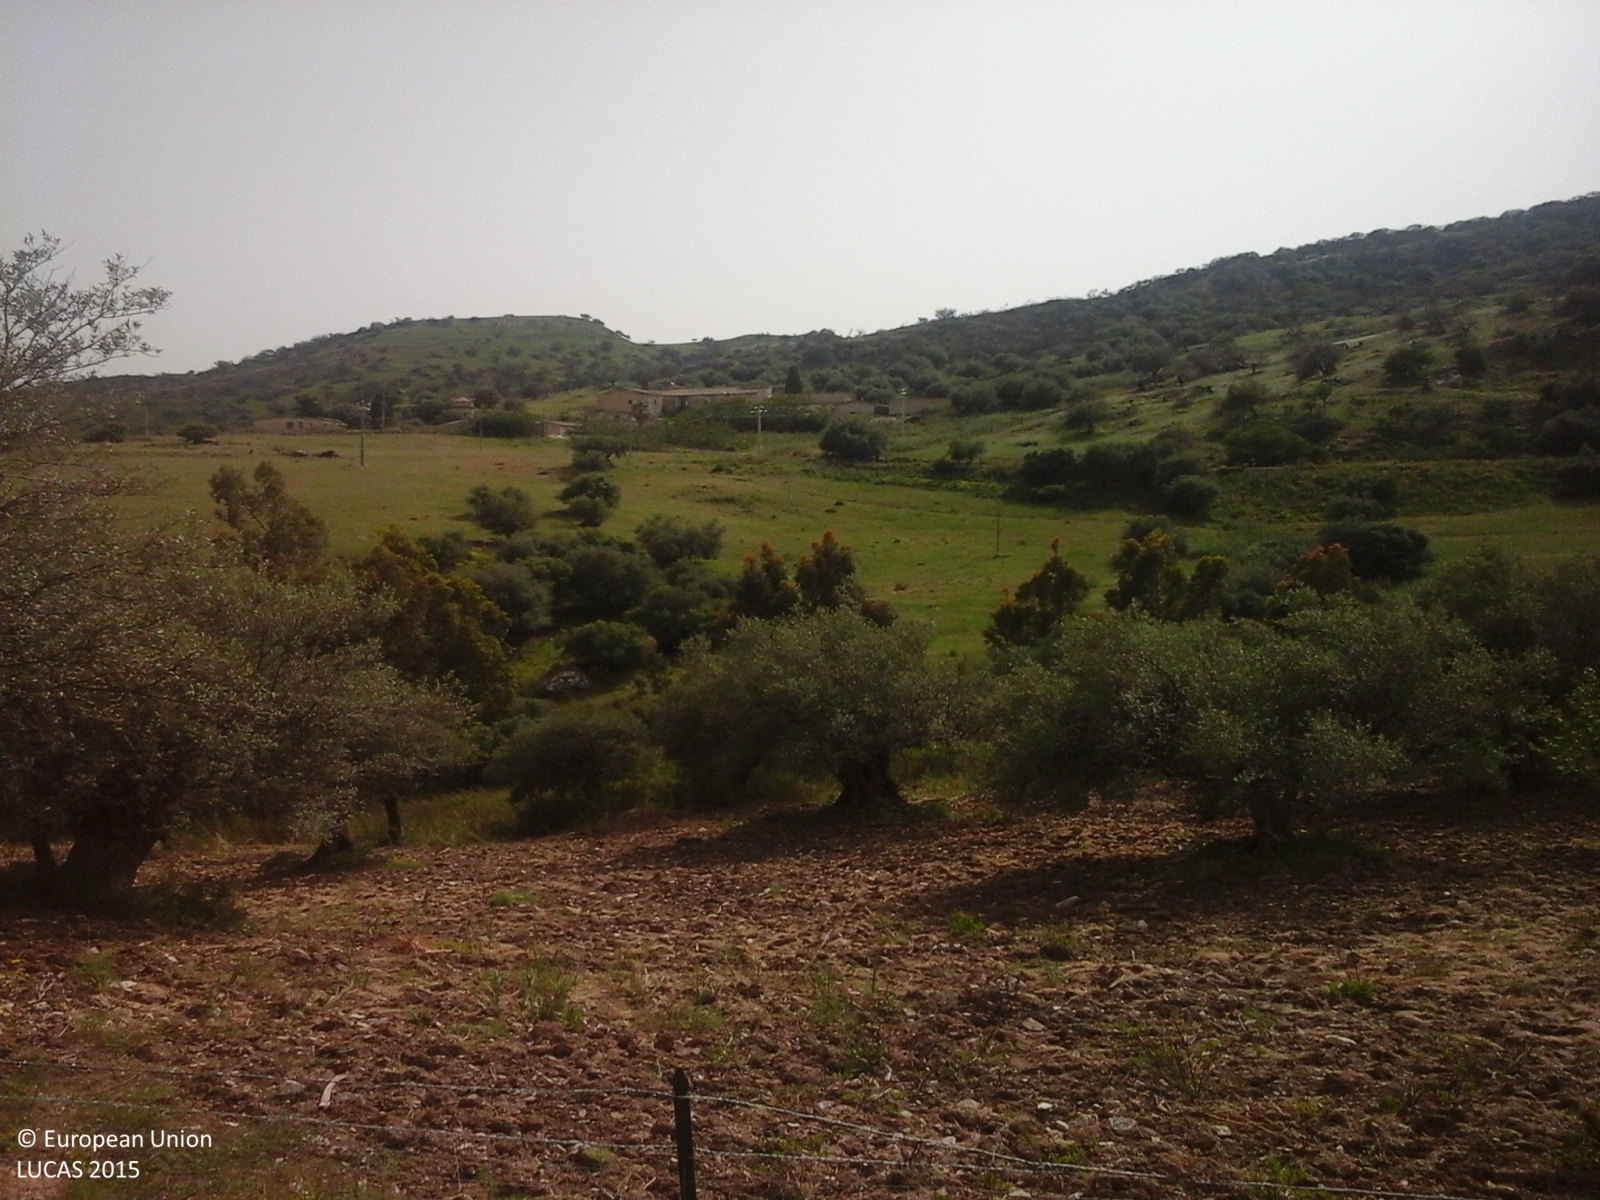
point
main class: Cropland
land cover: Olive groves
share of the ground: > 75 %
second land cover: Grassland without tree/shrub cover
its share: > 75 %
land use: Agriculture (excluding fallow land and kitchen gardens)
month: May
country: IT
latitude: 37.5757
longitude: 13.9226
